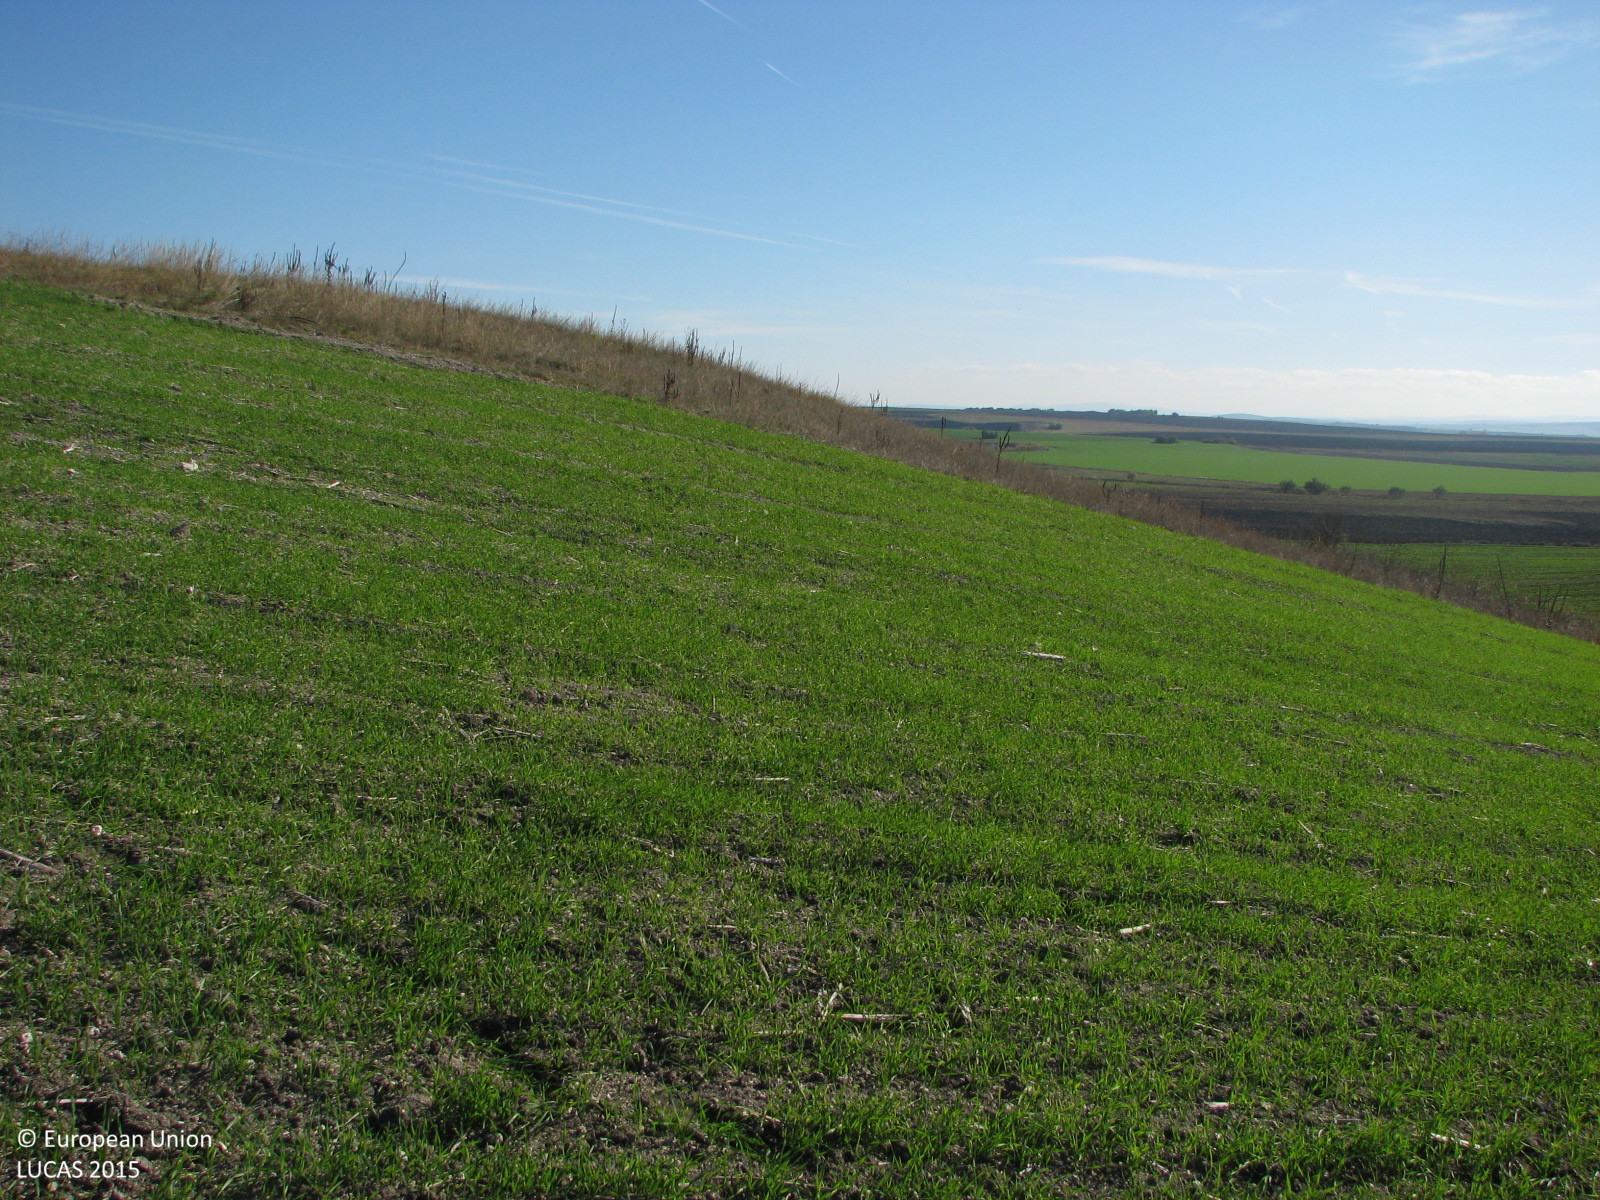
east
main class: Cropland
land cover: Common wheat
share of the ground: 50 - 75 %
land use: Agriculture (excluding fallow land and kitchen gardens)
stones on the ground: < 10 %
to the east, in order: Common wheat; Spontaneously vegetated surfaces; Common wheat
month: November
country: BG
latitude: 42.1566
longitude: 26.4864
